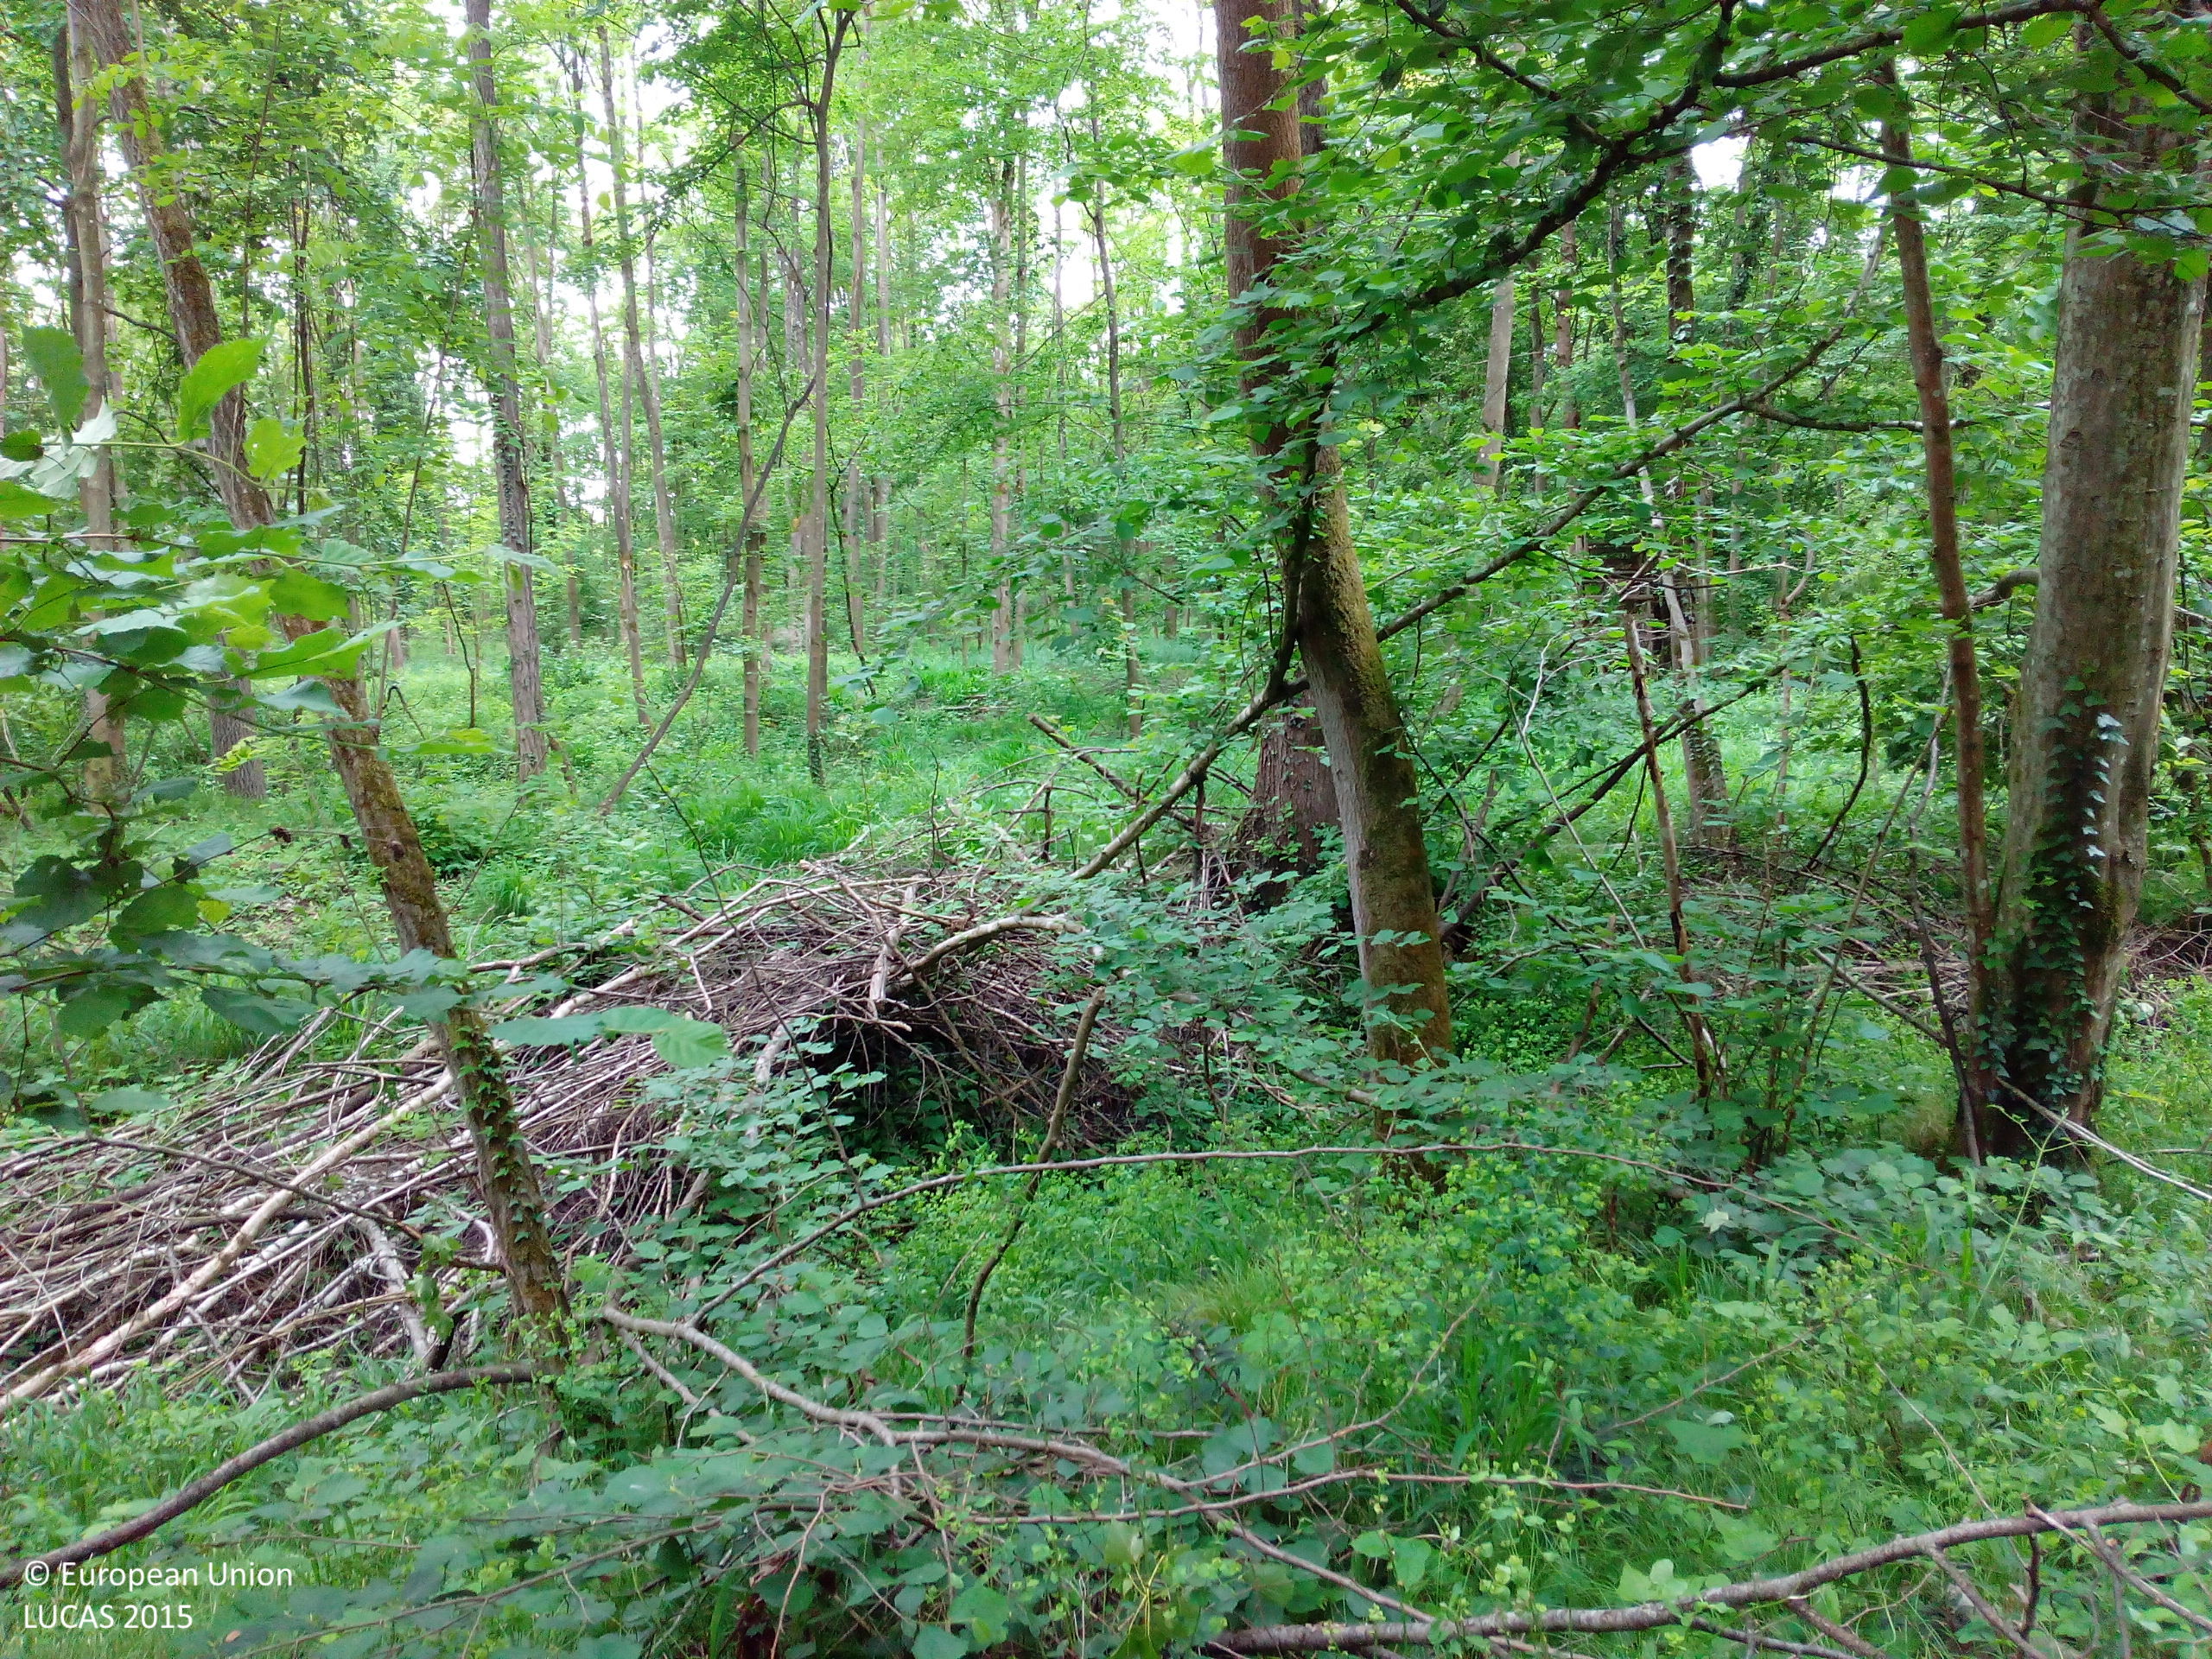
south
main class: Woodland
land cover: Broadleaved woodland
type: floodplain forest
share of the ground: > 75 %
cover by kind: broadleaved forest trees 85 %, shrubs 10 %, herbaceous plants 5 %
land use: Forestry
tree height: > 5 m
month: May
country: DE
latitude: 47.9641
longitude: 7.6306
